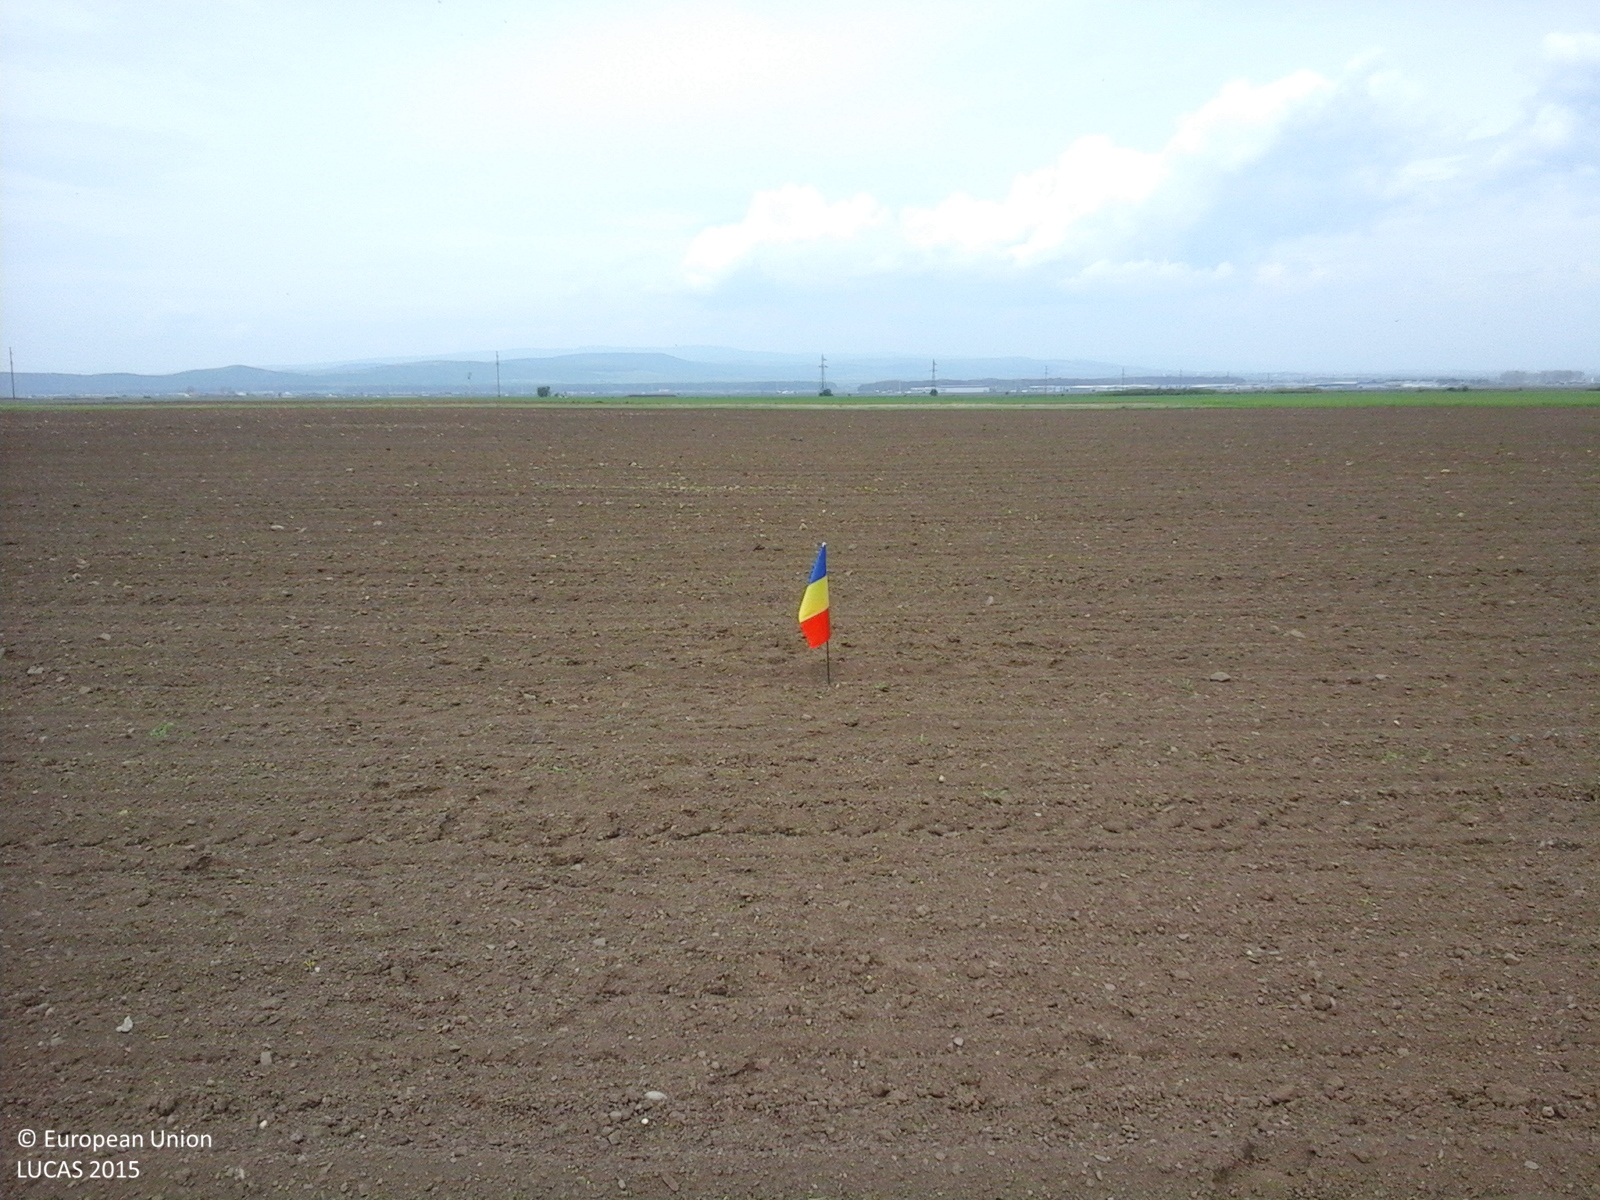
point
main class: Cropland
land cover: Maize
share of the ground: < 10 %
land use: Agriculture (excluding fallow land and kitchen gardens)
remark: Tilled/Sowed
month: May
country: RO
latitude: 45.6907
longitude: 25.7356
